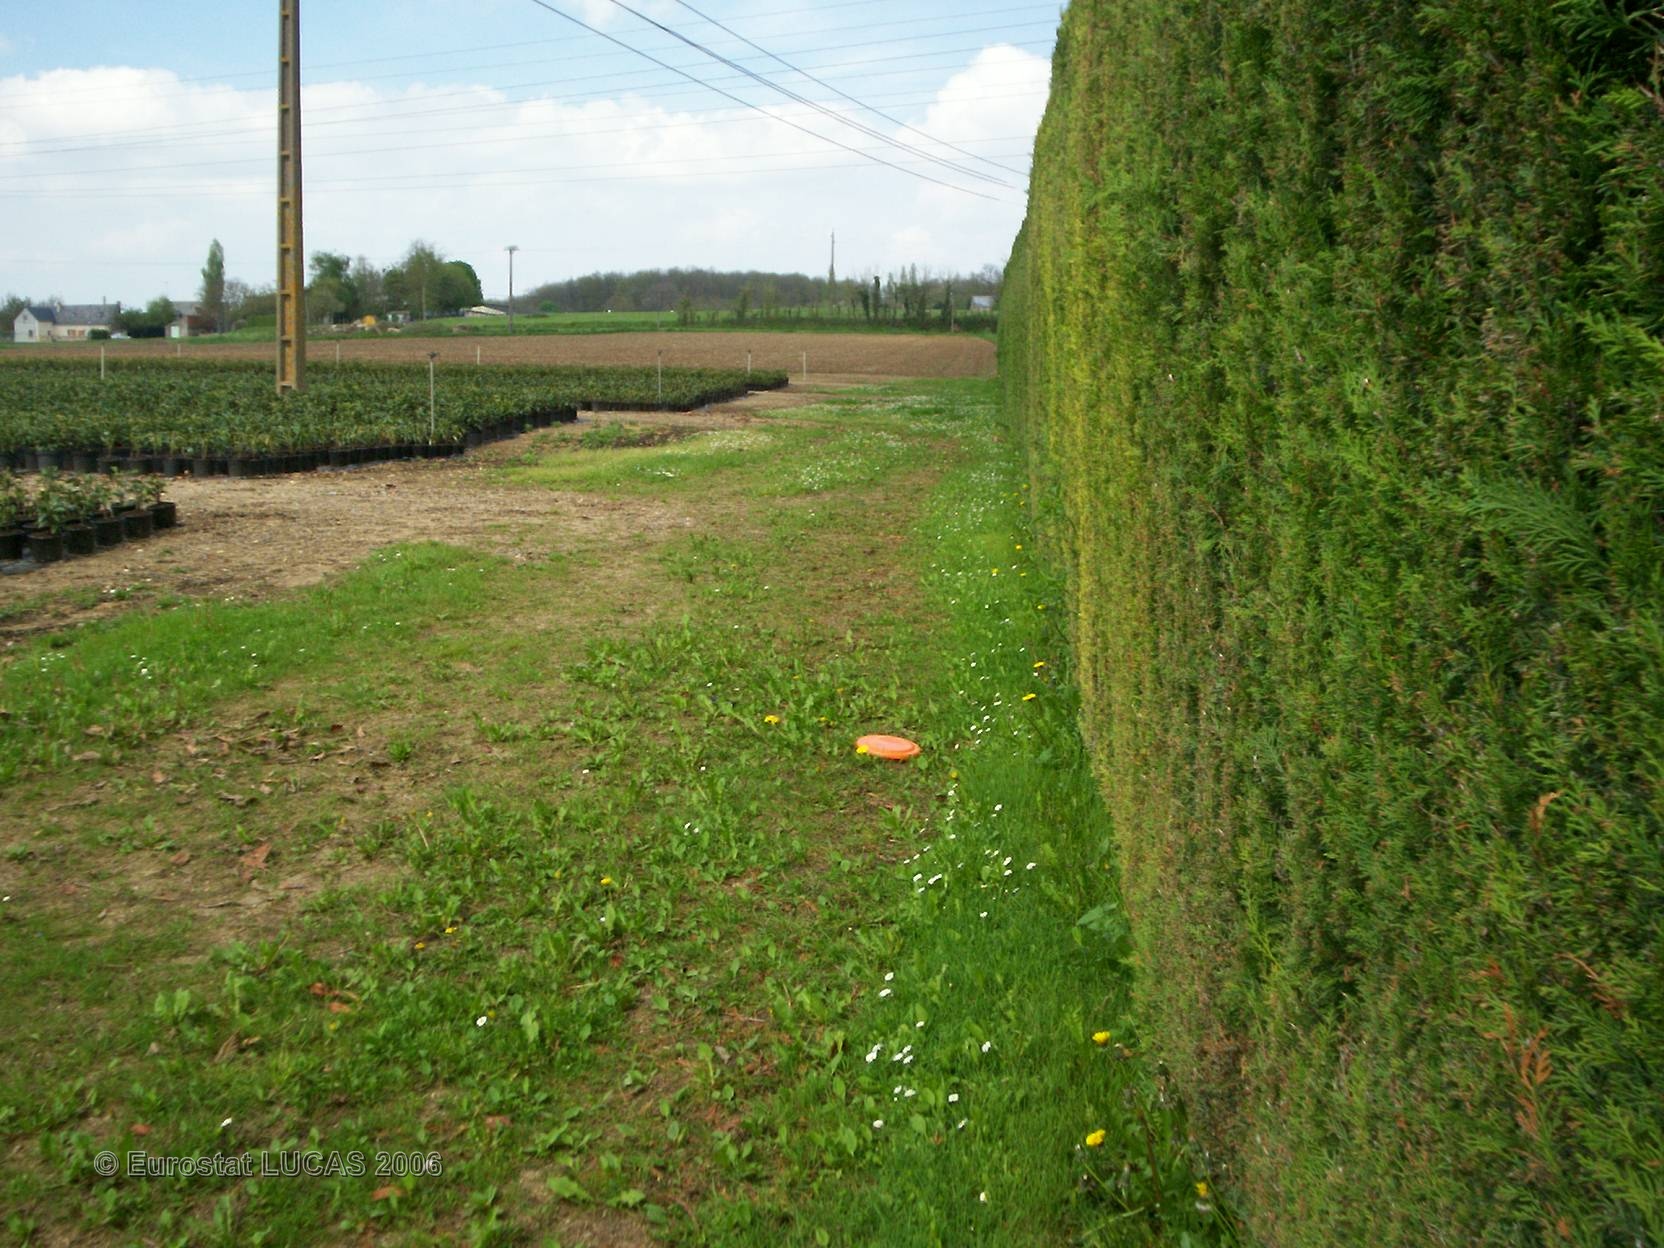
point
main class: Grassland
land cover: Grassland without tree/shrub cover
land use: Agriculture (excluding fallow land and kitchen gardens)
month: April
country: FR
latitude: 47.3498
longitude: -0.3943
